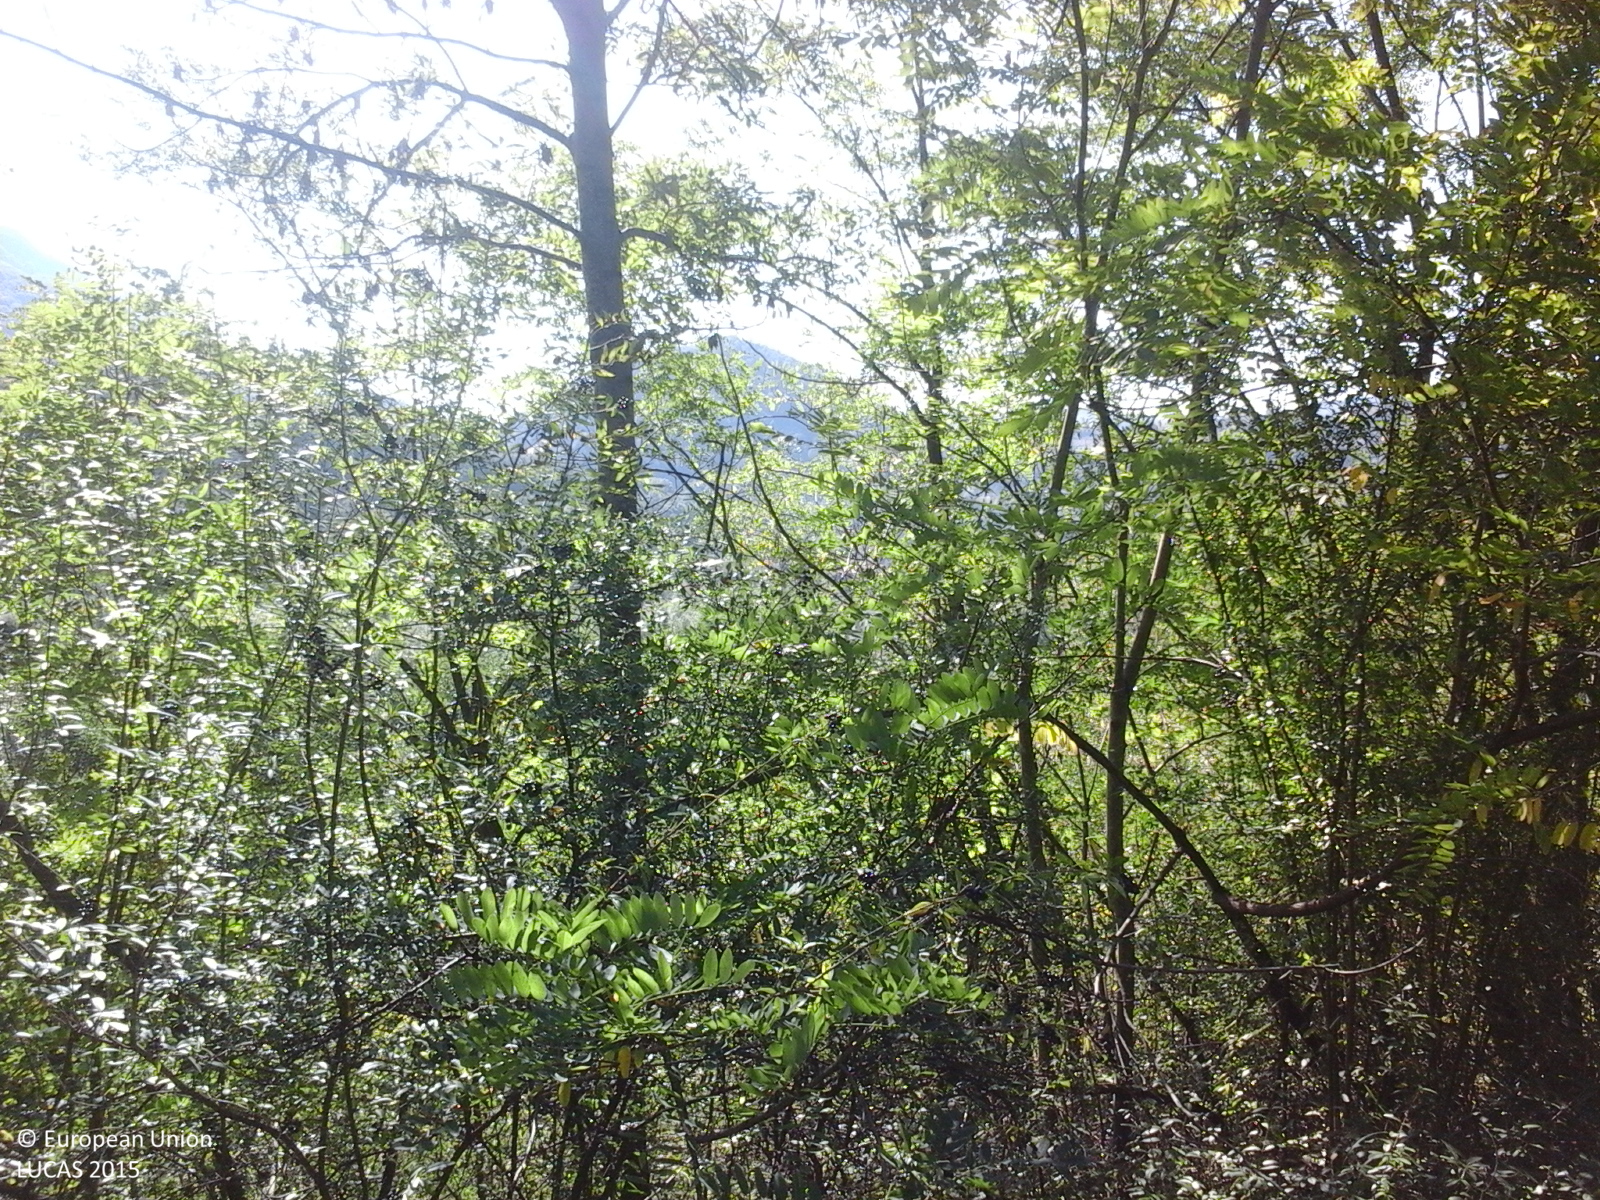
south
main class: Grassland
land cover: Grassland without tree/shrub cover
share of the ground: > 75 %
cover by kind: herbaceous plants 100 %
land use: Agriculture (excluding fallow land and kitchen gardens)
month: October
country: RO
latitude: 46.4446
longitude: 23.4612
